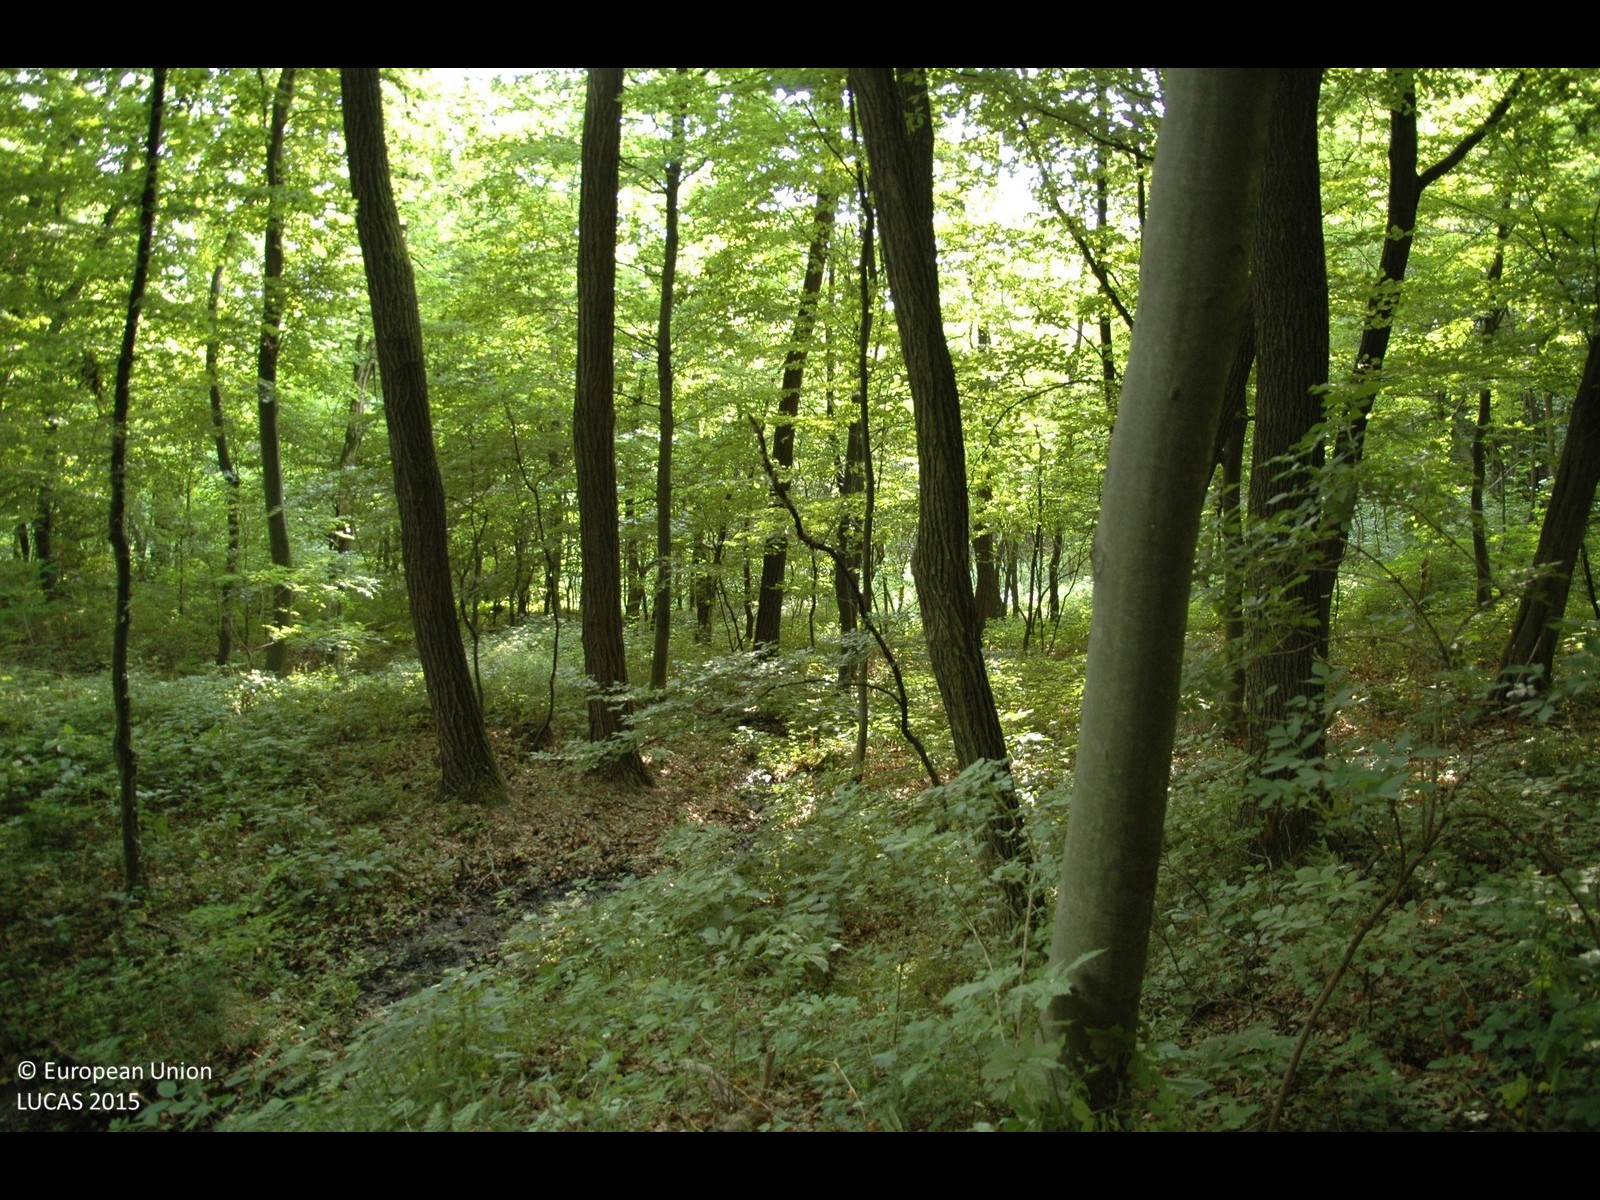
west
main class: Woodland
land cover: Broadleaved woodland
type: beech forest
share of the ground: > 75 %
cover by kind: broadleaved forest trees 100 %
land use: Forestry
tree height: > 5 m
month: June
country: HR
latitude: 46.4879
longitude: 16.3450
